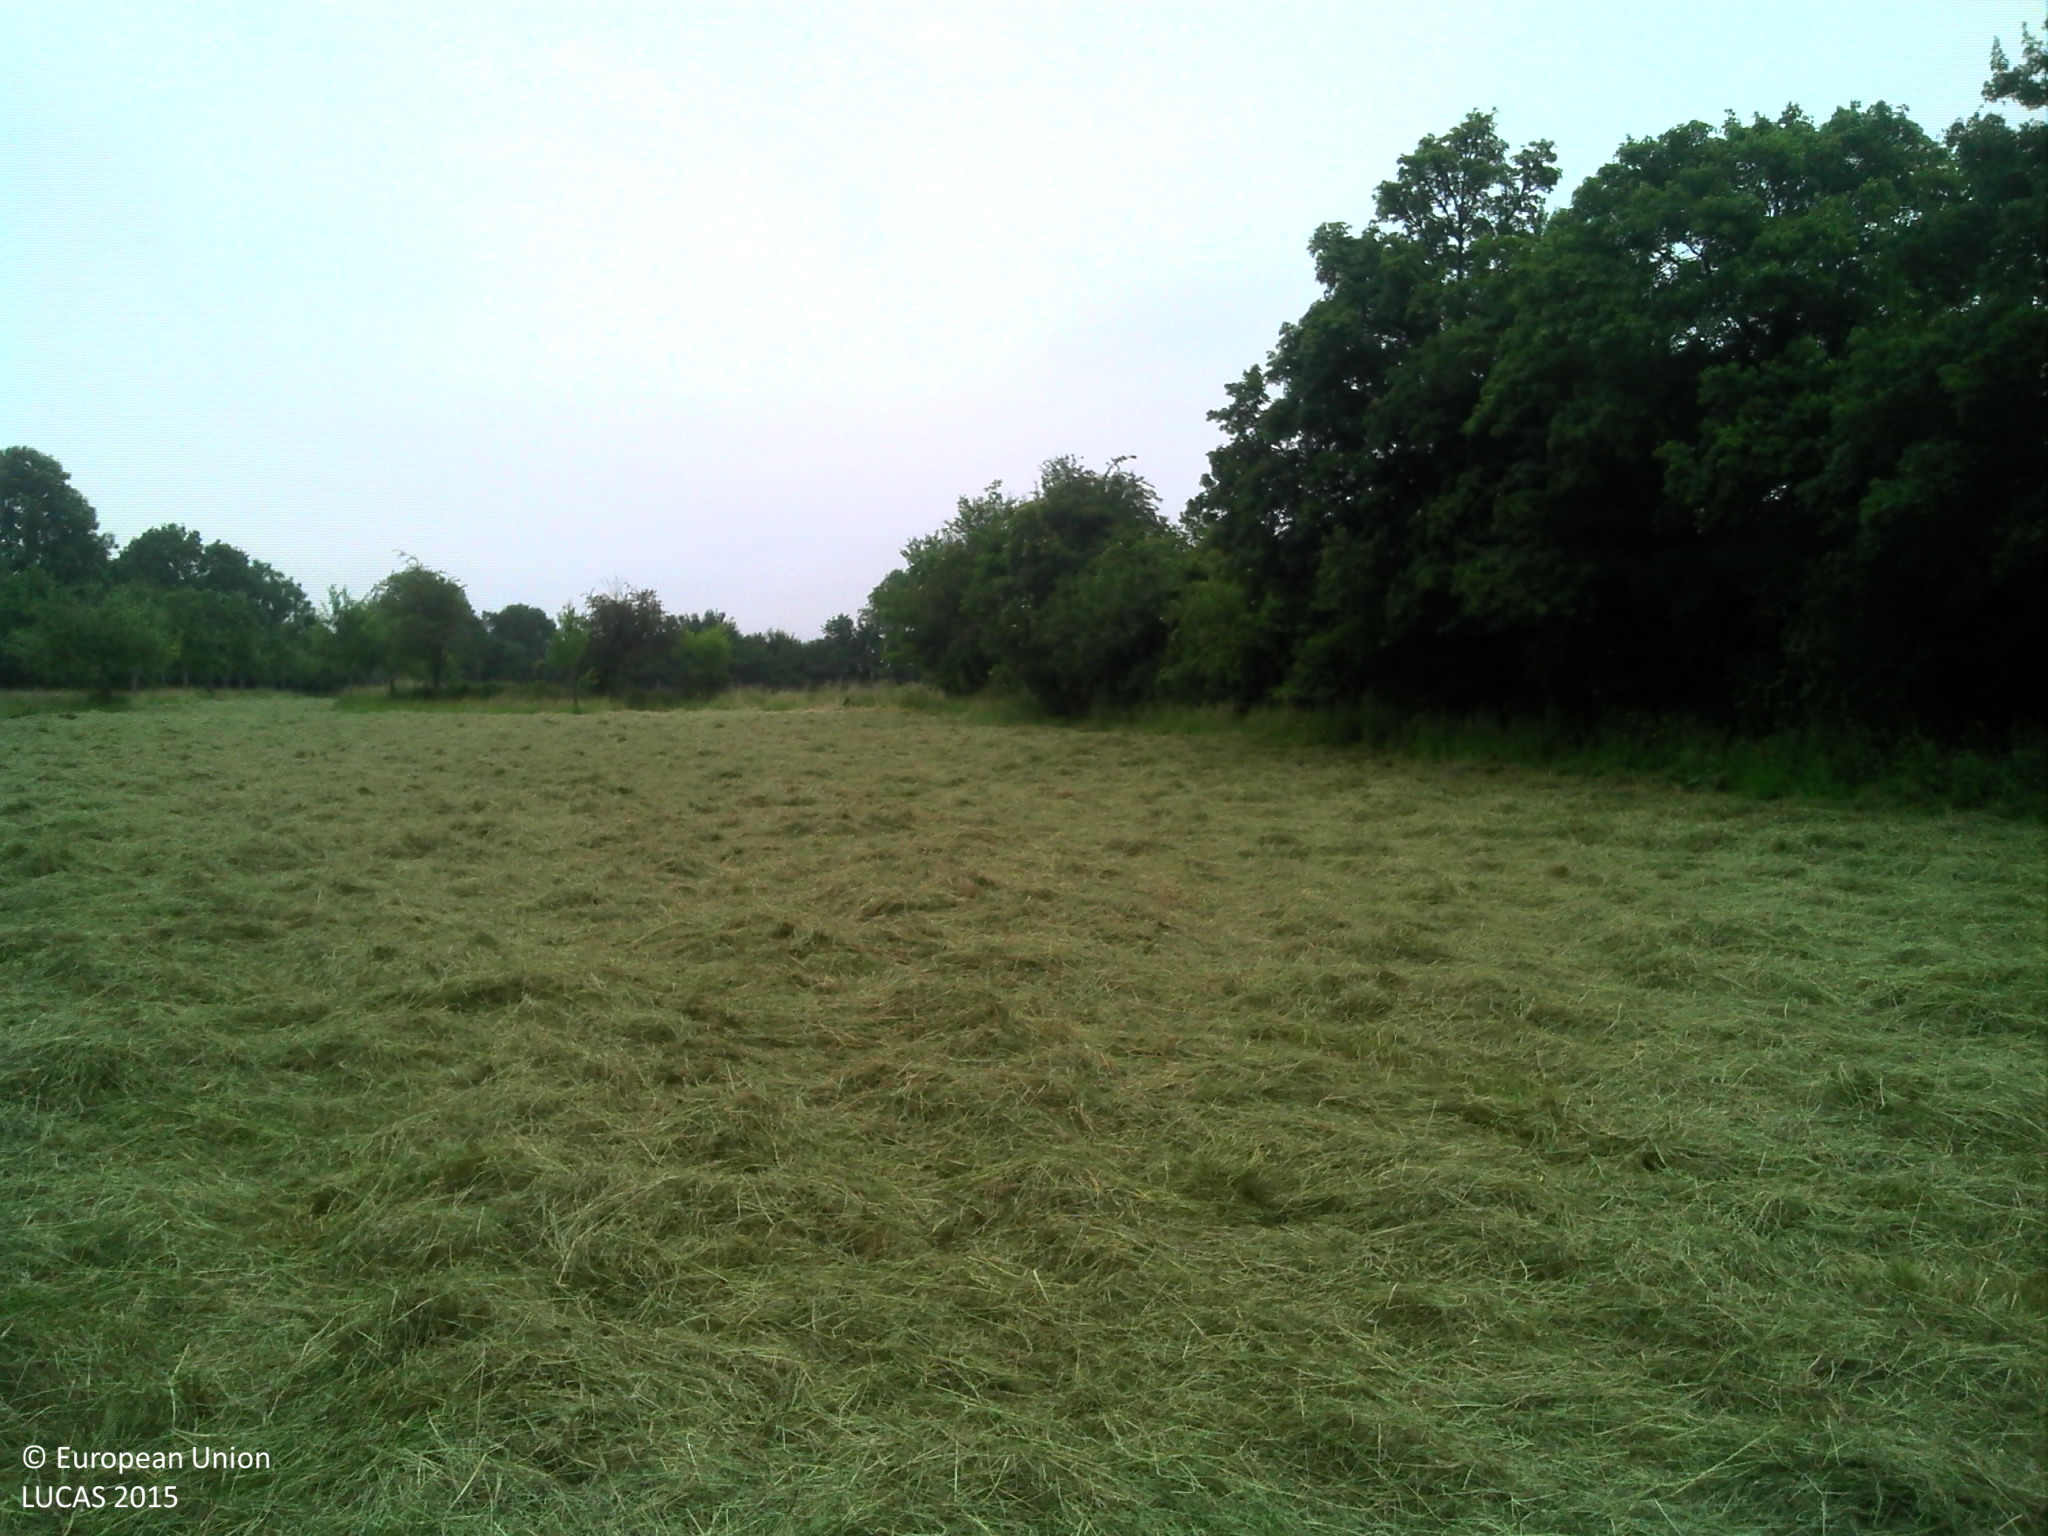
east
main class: Grassland
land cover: Grassland without tree/shrub cover
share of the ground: > 75 %
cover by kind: herbaceous plants 100 %
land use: Agriculture (excluding fallow land and kitchen gardens)
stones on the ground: < 10 %
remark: Harvested field
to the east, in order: Grassland without tree/shrub cover; Fences; Grassland without tree/shrub cover; Single bushes/trees; Grassland without tree/shrub cover; Broadleaved woodland; Grassland without tree/shrub cover
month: June
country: FR
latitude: 48.7541
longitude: 0.0821
